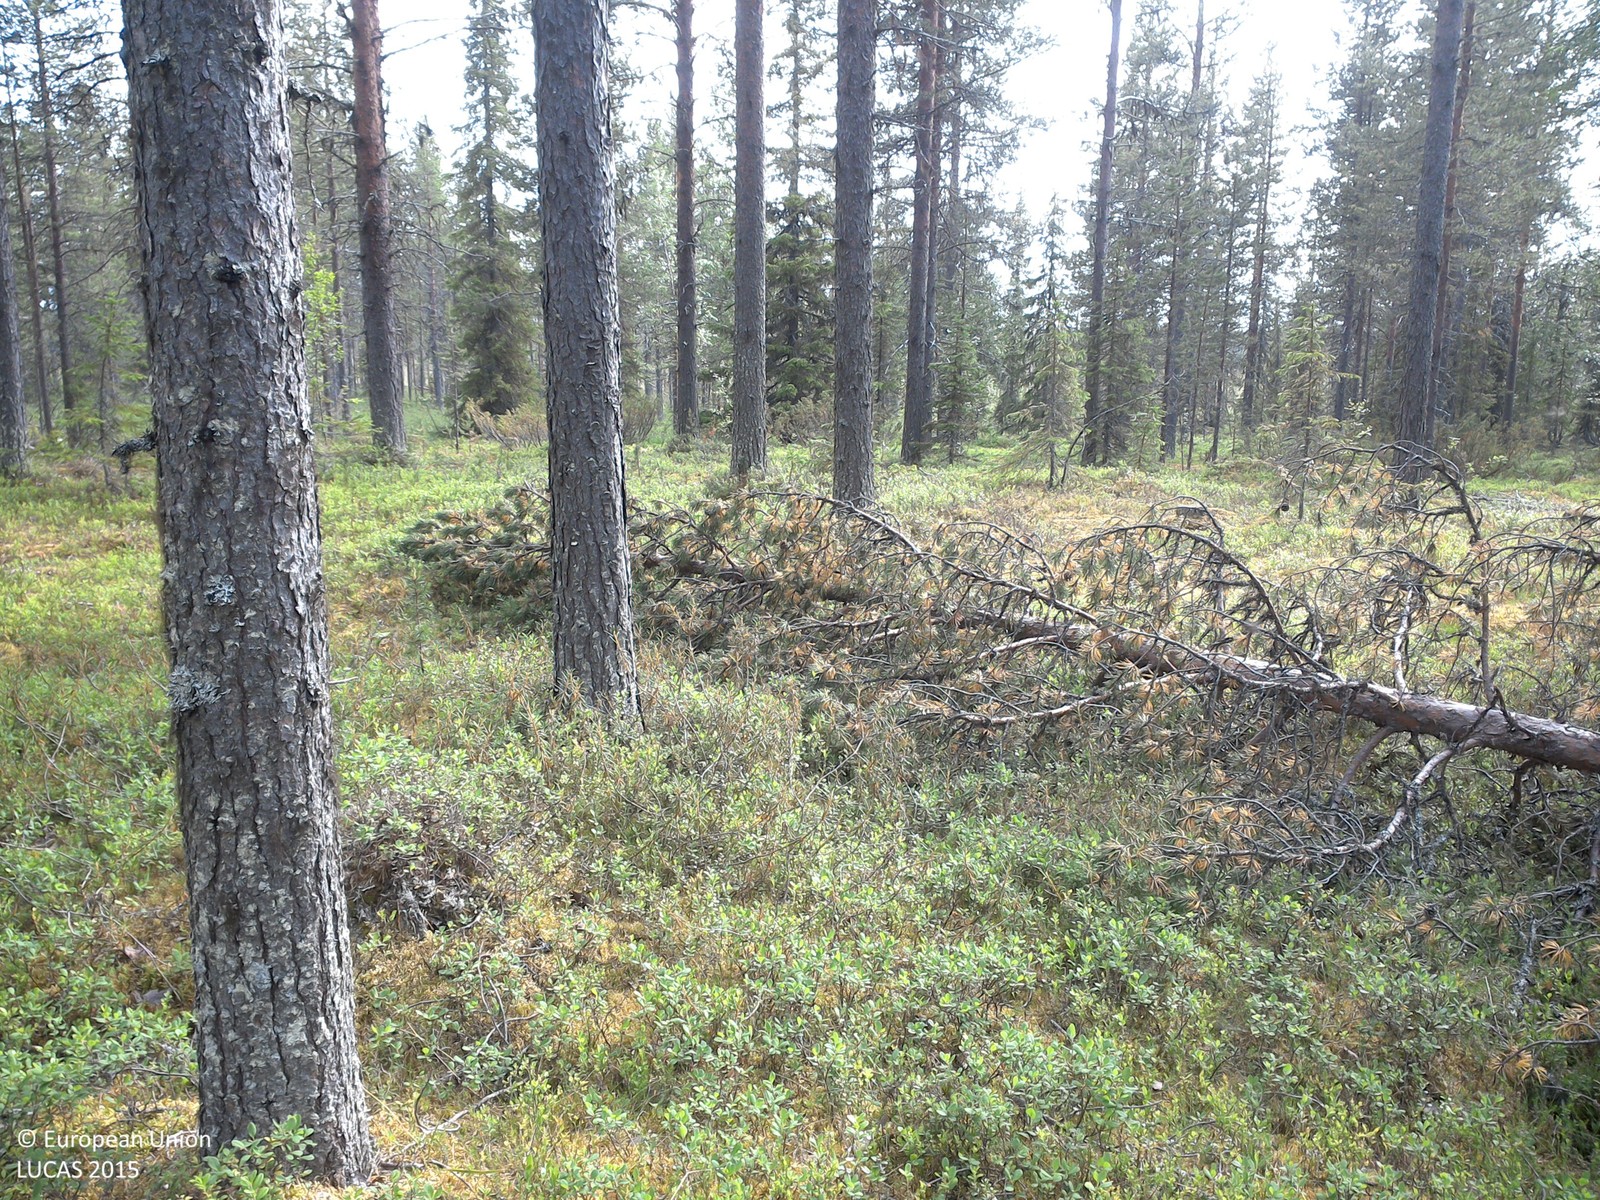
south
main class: Woodland
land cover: Pine dominated coniferous woodland
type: boreal forest
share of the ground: 25 - 50 %
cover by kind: shrubs 50 %, coniferous forest trees 35 %, lichens and mosses 15 %
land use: Forestry
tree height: > 5 m
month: July
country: SE
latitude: 67.6458
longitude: 22.7995
